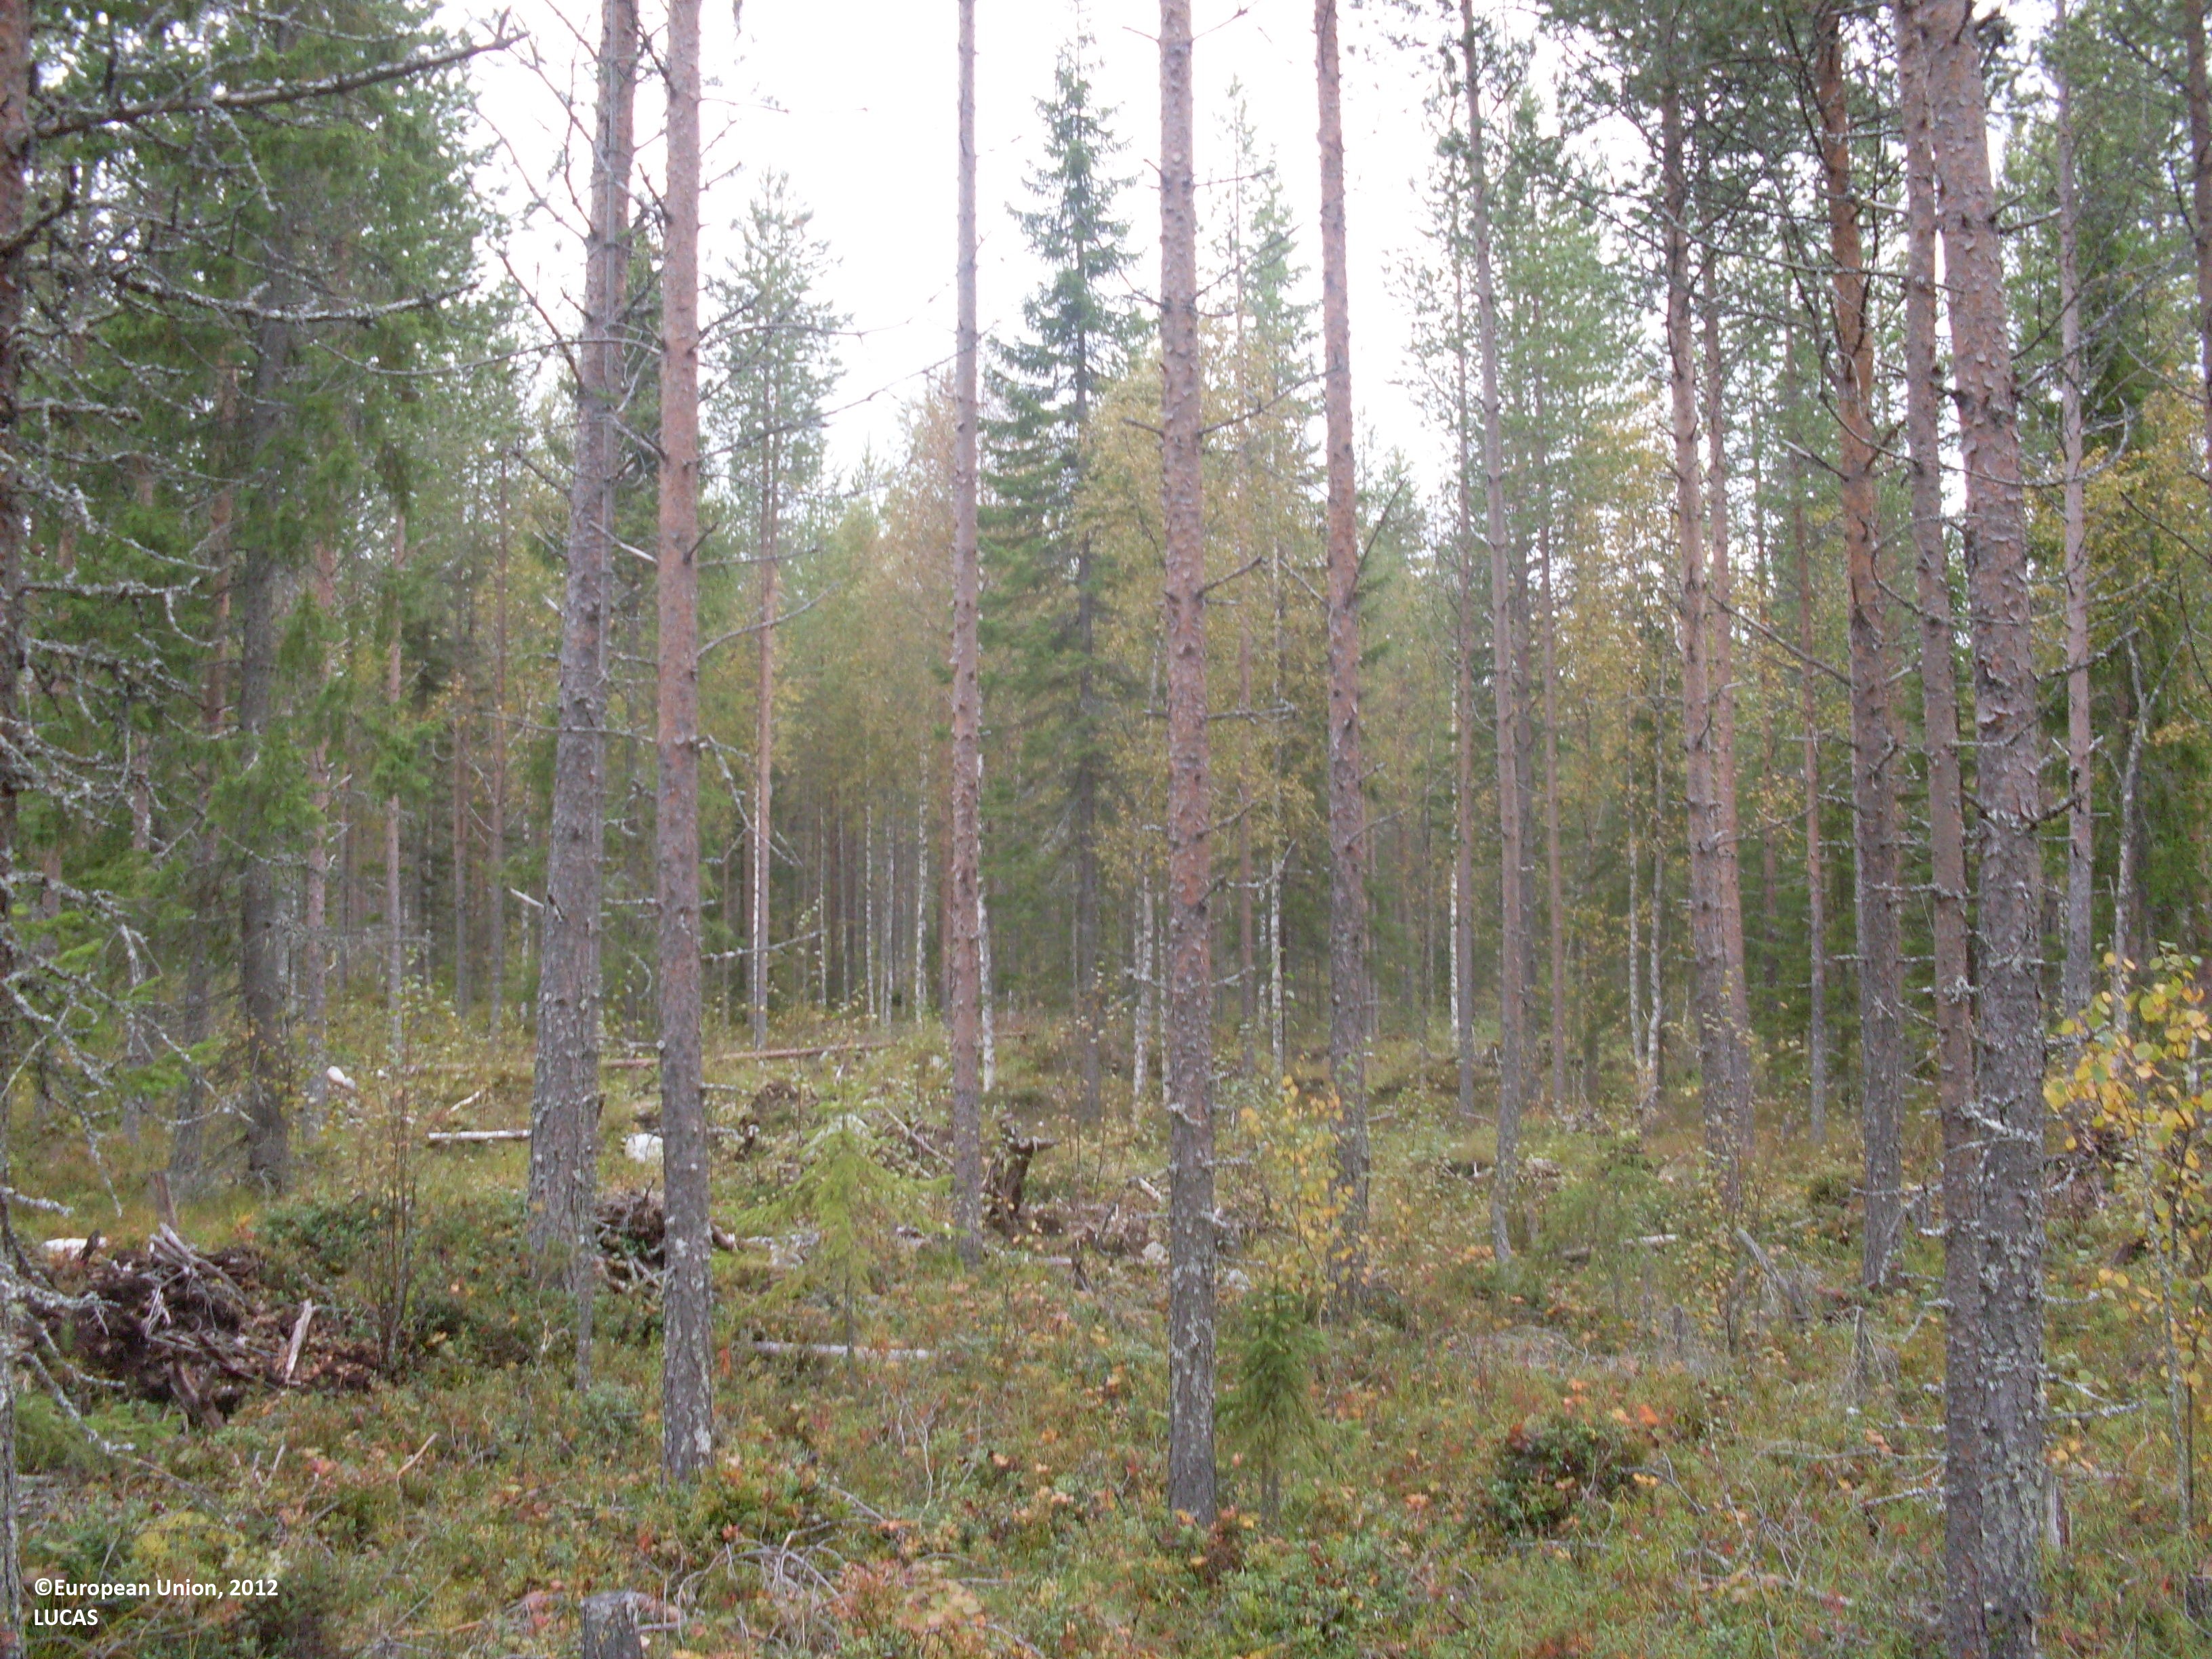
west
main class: Woodland
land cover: Pine dominated coniferous woodland
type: boreal forest
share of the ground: > 75 %
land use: Forestry
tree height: > 5 m
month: September
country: FI
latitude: 64.0416
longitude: 29.7010
